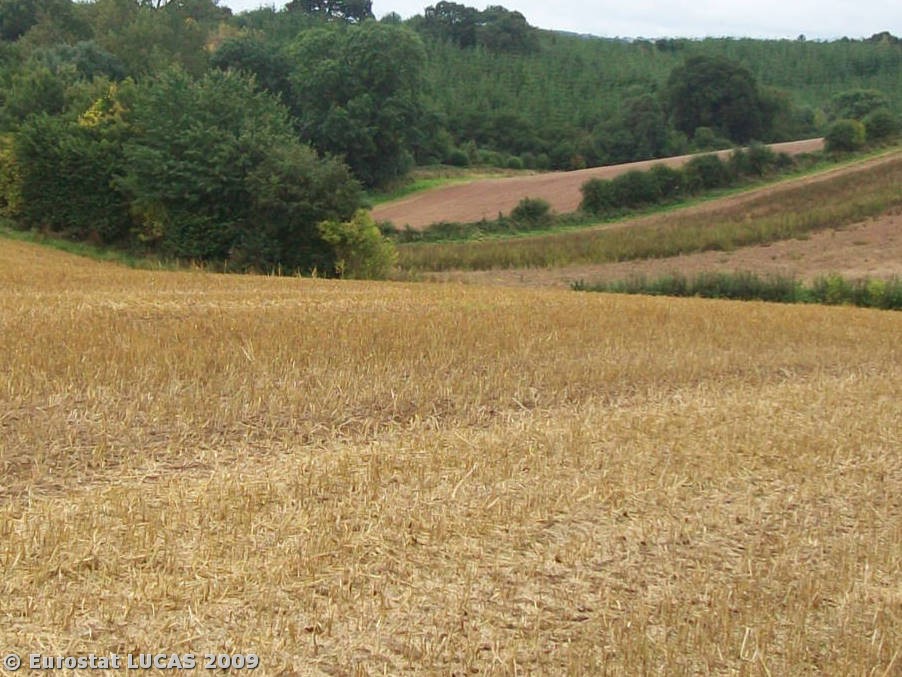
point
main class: Cropland
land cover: Common wheat
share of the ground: < 10 %
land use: Agriculture (excluding fallow land and kitchen gardens)
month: September
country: GB
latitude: 52.5832
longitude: -2.5380
